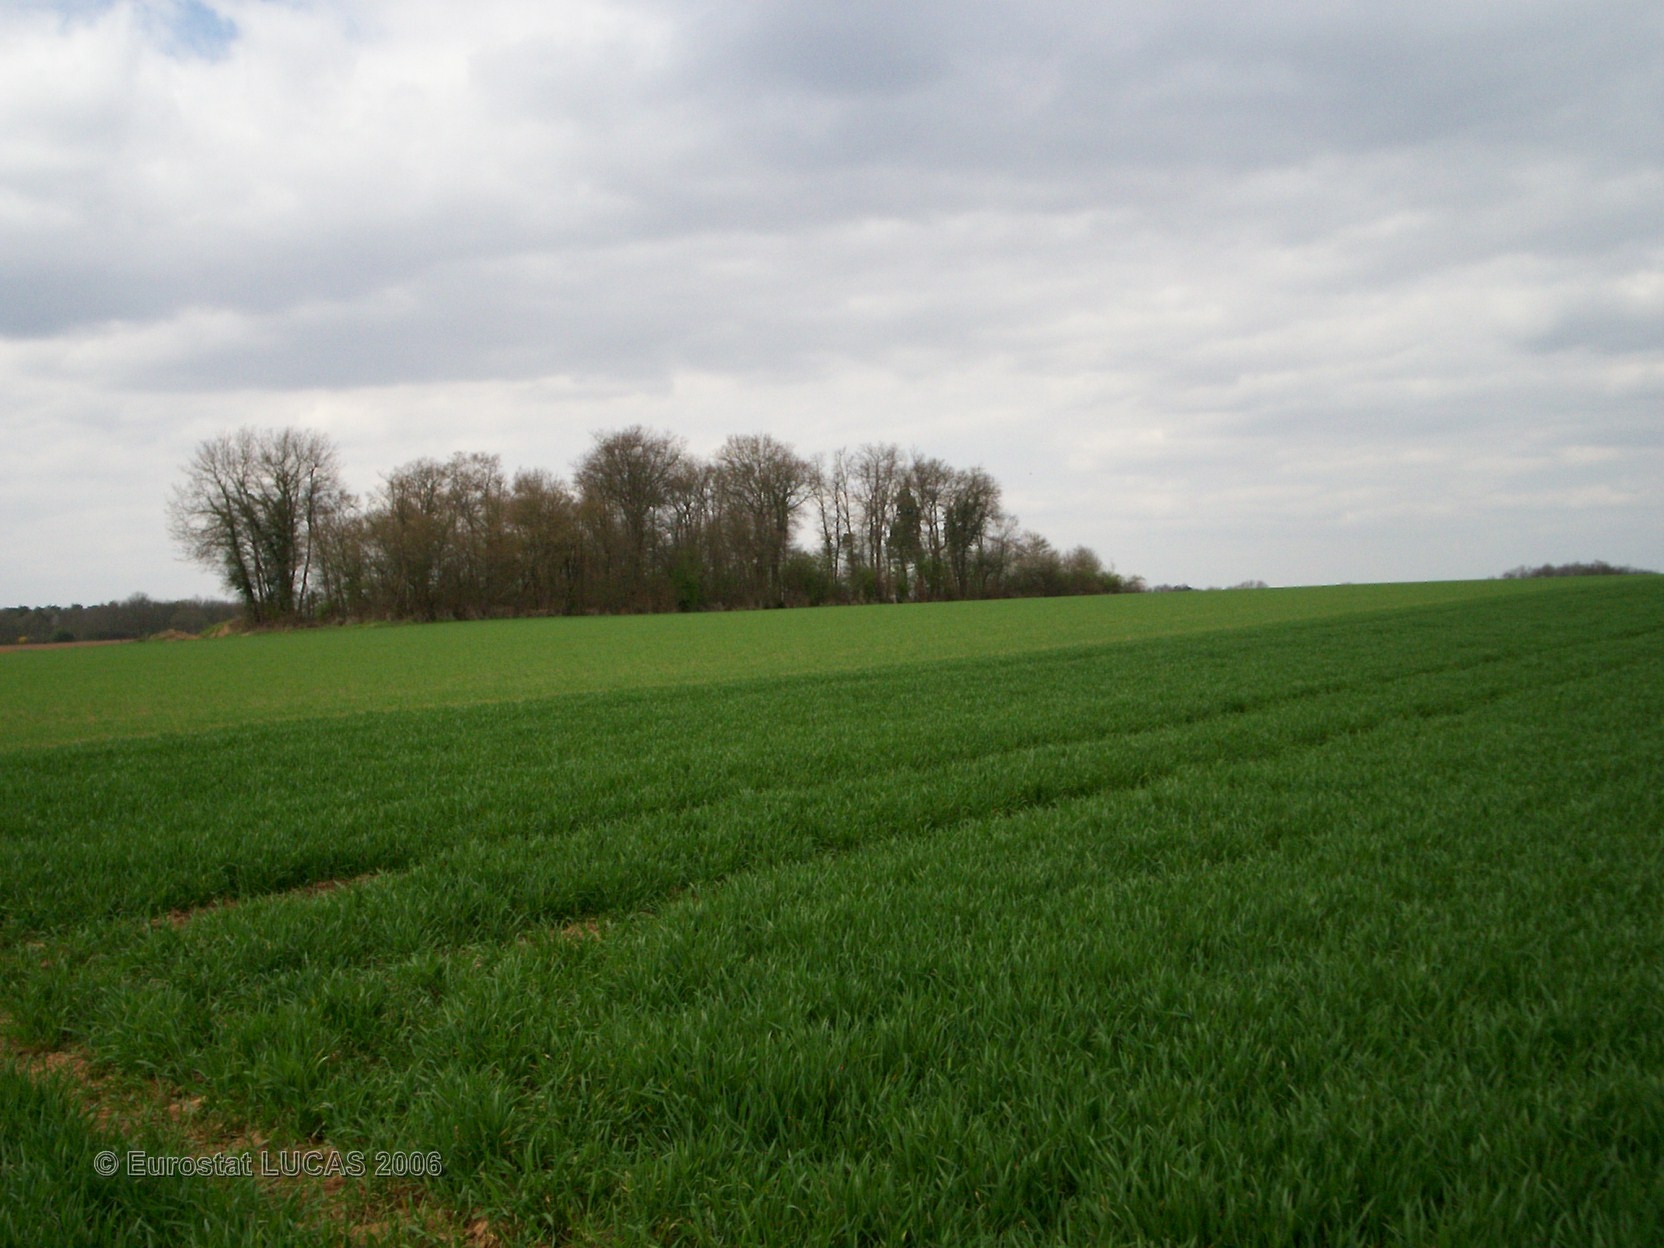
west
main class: Cropland
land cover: Common wheat
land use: Agriculture (excluding fallow land and kitchen gardens)
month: April
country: FR
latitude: 48.2615
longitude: 2.8387
